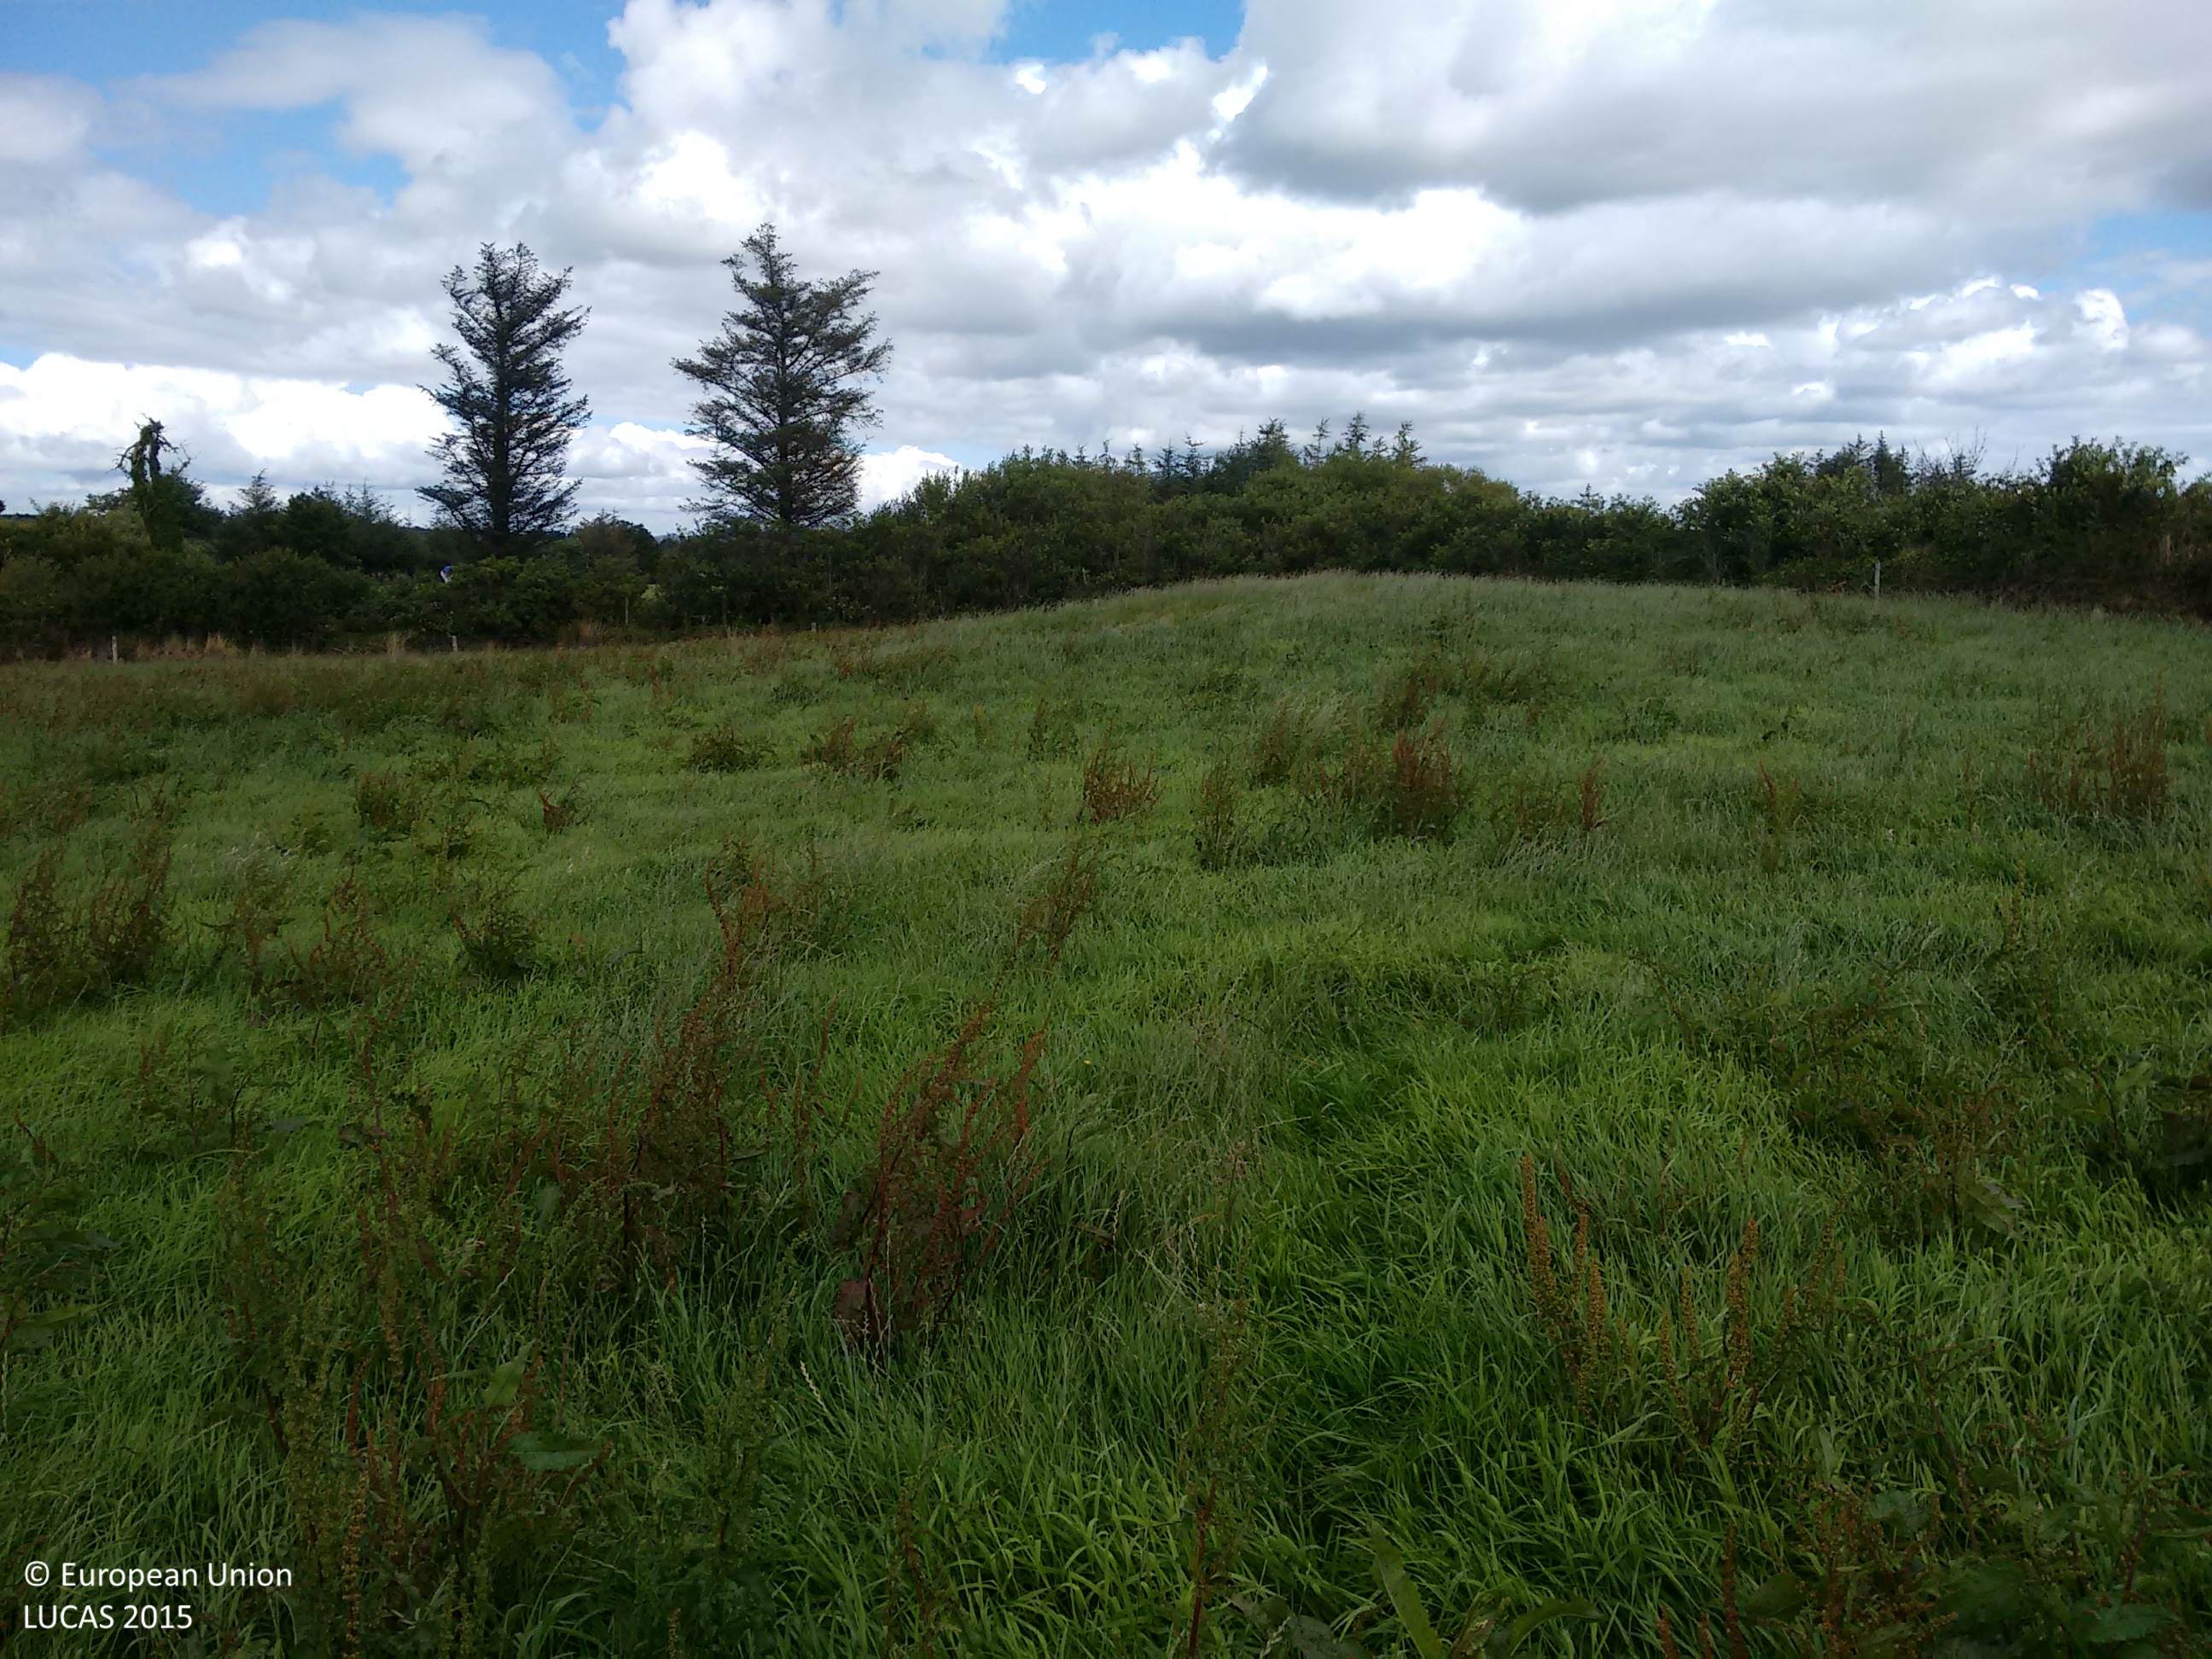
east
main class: Grassland
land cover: Grassland without tree/shrub cover
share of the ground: > 75 %
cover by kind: herbaceous plants 100 %
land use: Agriculture (excluding fallow land and kitchen gardens)
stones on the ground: < 10 %
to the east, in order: Grassland without tree/shrub cover; Fences; Artificial constructions; Abandoned hedges; Grassland without tree/shrub cover; Paved roads, cycling and walking lanes; Grassland without tree/shrub cover; Broadleaved woodland; Grassland without tree/shrub cover
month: July
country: IE
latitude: 51.5306
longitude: -9.2957
